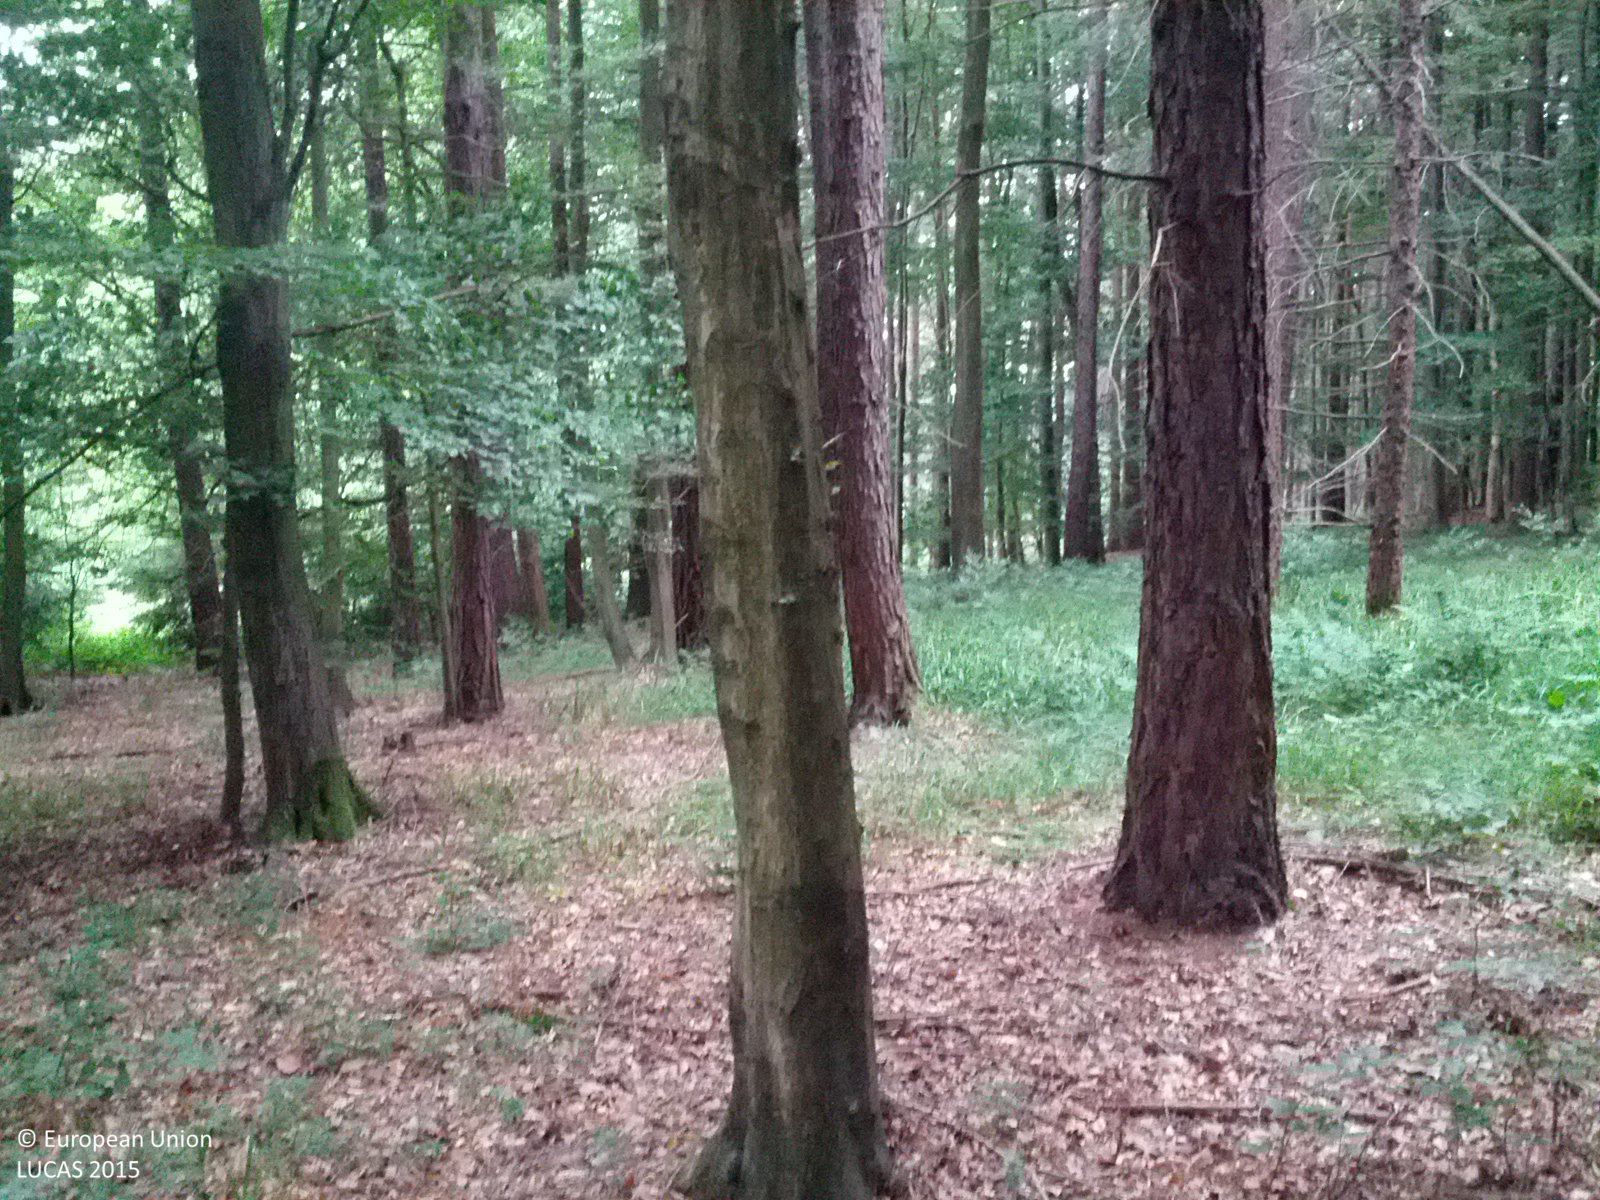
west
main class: Woodland
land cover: Other mixed woodland
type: alpine coniferous forest
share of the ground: > 75 %
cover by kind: coniferous forest trees 40 %, broadleaved forest trees 40 %, herbaceous plants 15 %, shrubs 5 %
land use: Forestry
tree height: > 5 m
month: June
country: AT
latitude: 48.1976
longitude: 16.1257
